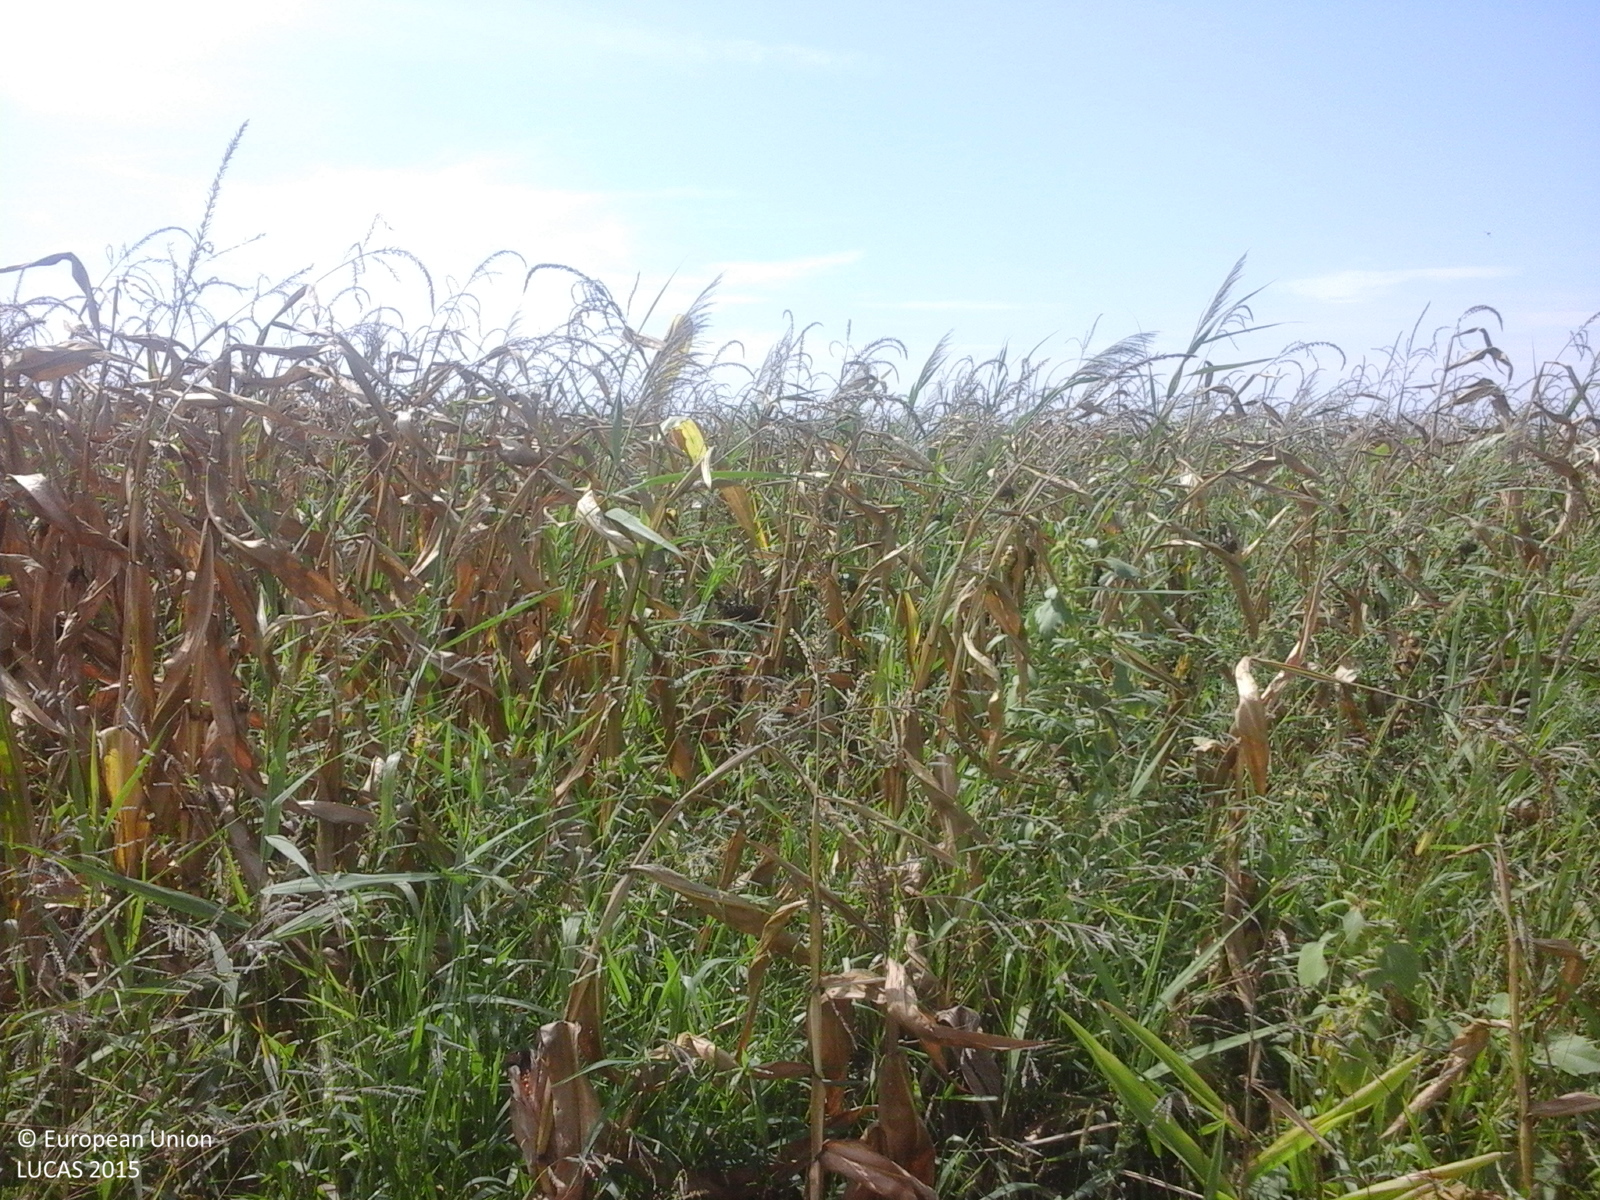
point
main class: Cropland
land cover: Maize
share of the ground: > 75 %
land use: Agriculture (excluding fallow land and kitchen gardens)
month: August
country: RO
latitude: 46.4485
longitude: 21.4010
